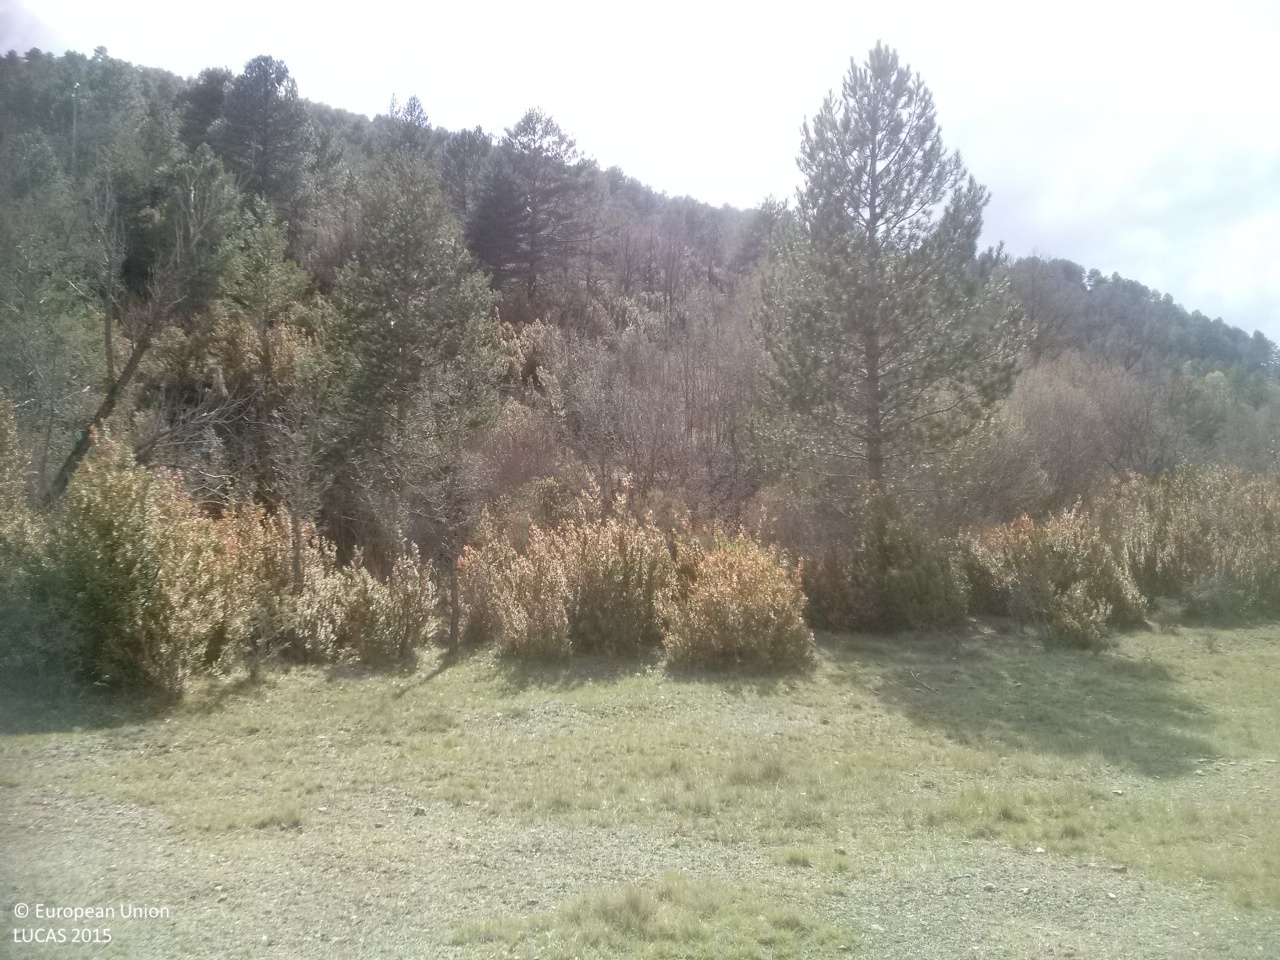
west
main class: Woodland
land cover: Pine dominated coniferous woodland
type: coniferous forest of the mediterranean region
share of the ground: > 75 %
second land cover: Grassland without tree/shrub cover
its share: 10 - 25 %
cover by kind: coniferous forest trees 80 %, shrubs 10 %, herbaceous plants 10 %
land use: Forestry
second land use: Agriculture (excluding fallow land and kitchen gardens)
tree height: > 5 m
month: April
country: ES
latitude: 40.2844
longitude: -1.7892
